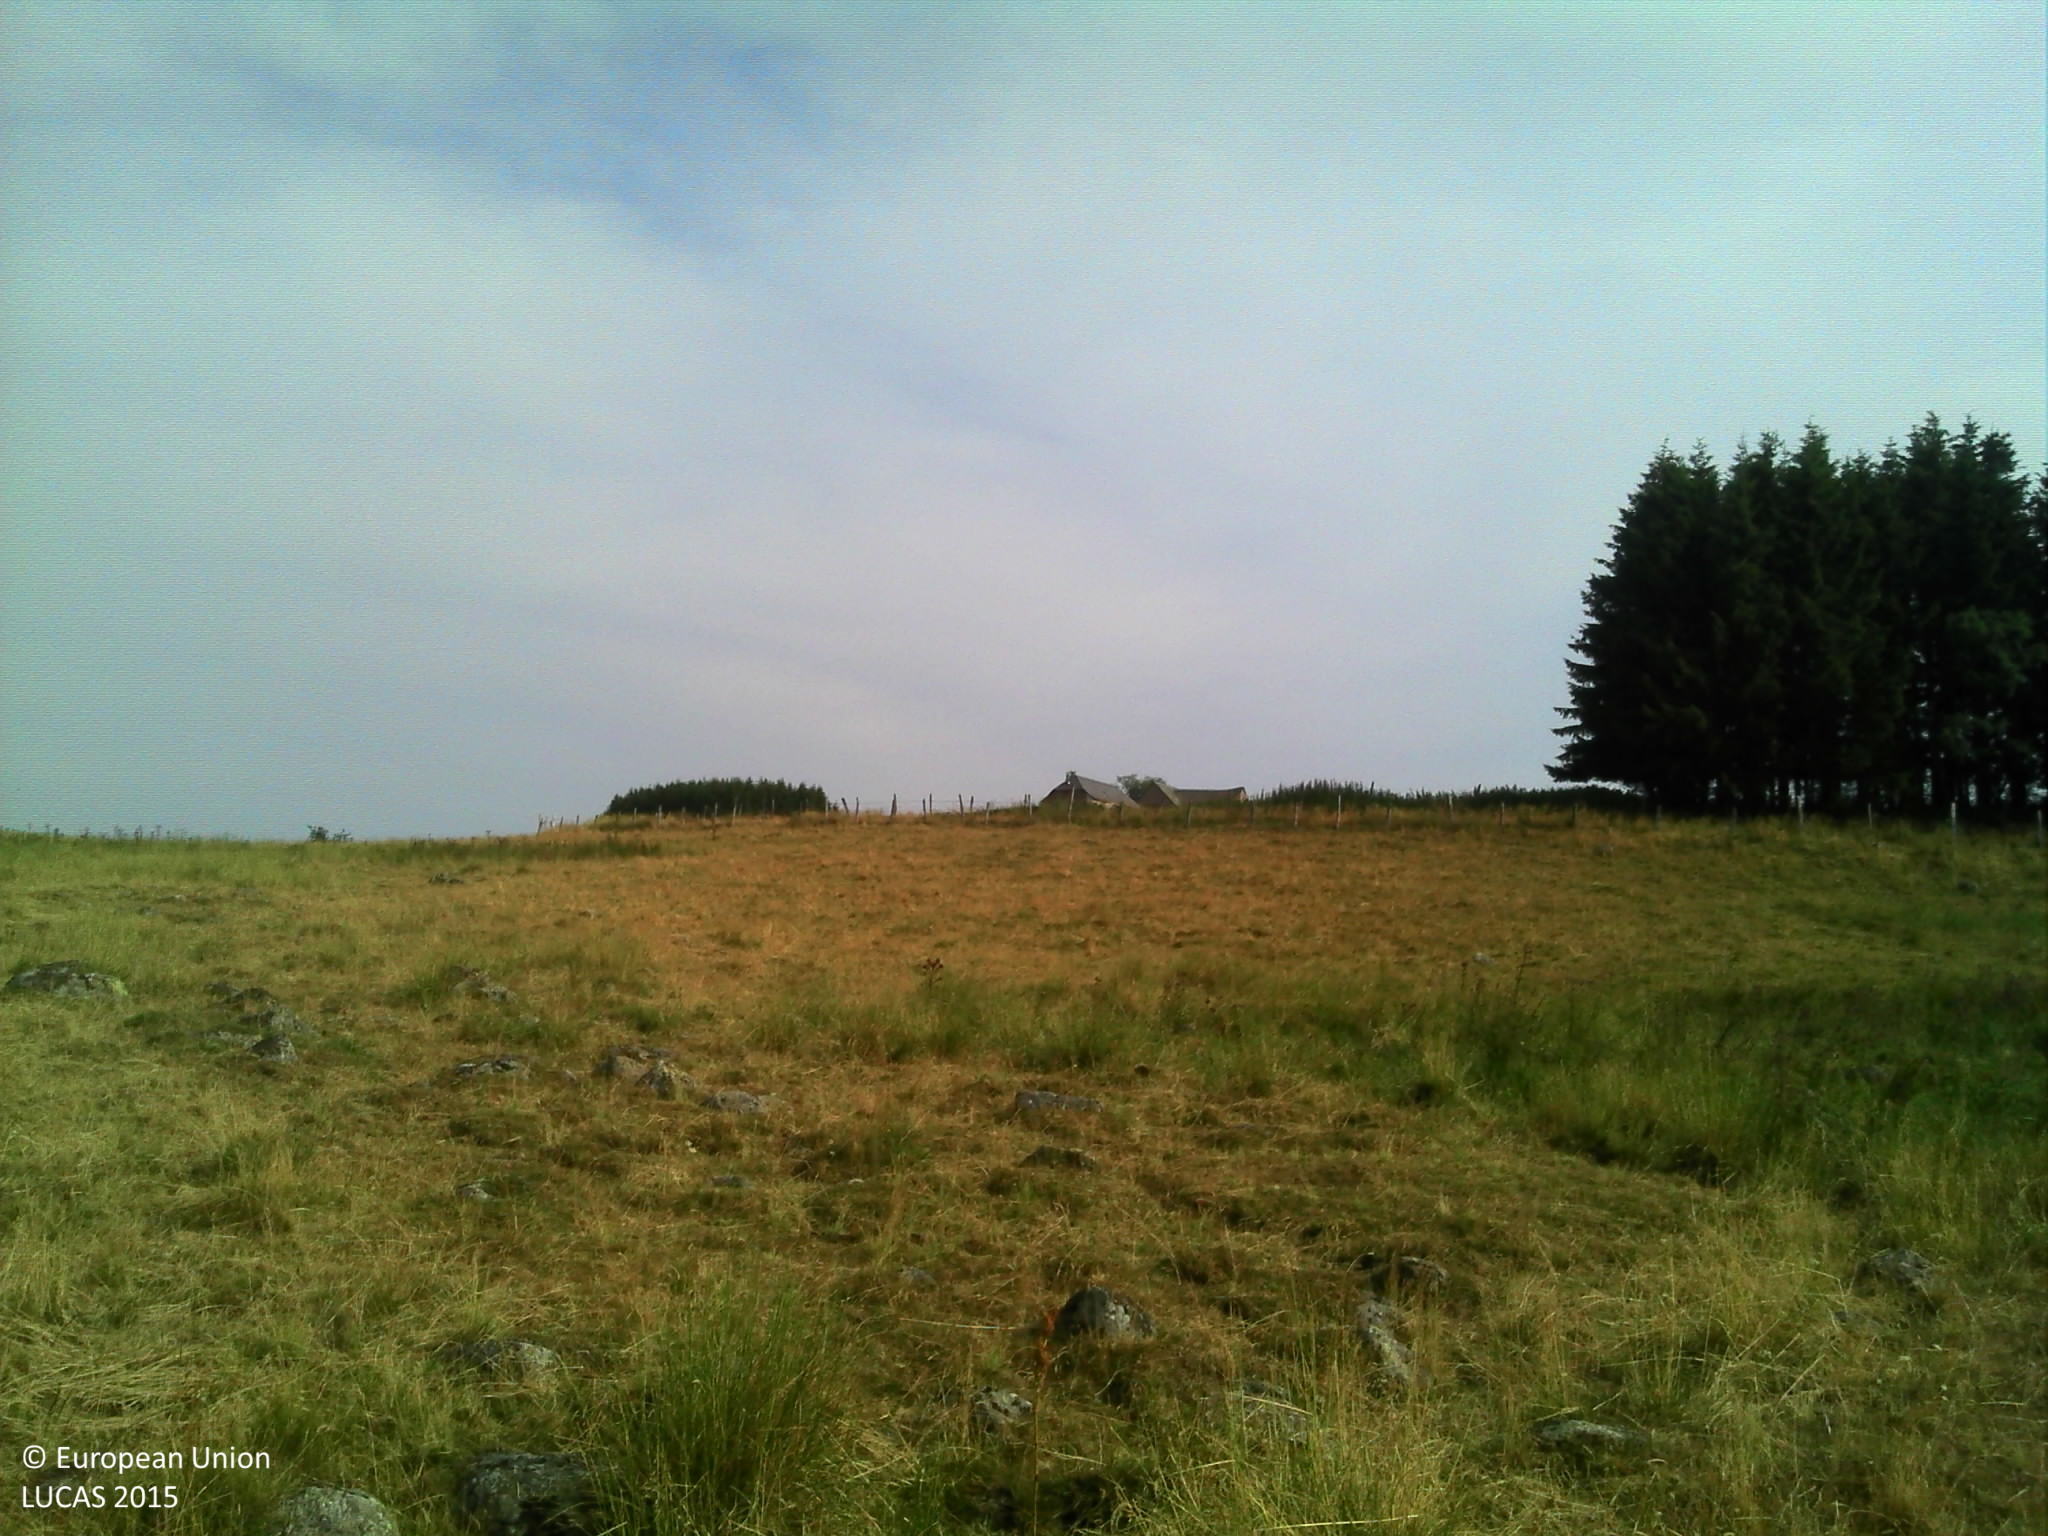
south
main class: Grassland
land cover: Grassland without tree/shrub cover
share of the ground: > 75 %
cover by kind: herbaceous plants 95 %, shrubs 5 %
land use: Agriculture (excluding fallow land and kitchen gardens)
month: July
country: FR
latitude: 44.6050
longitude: 3.0362
